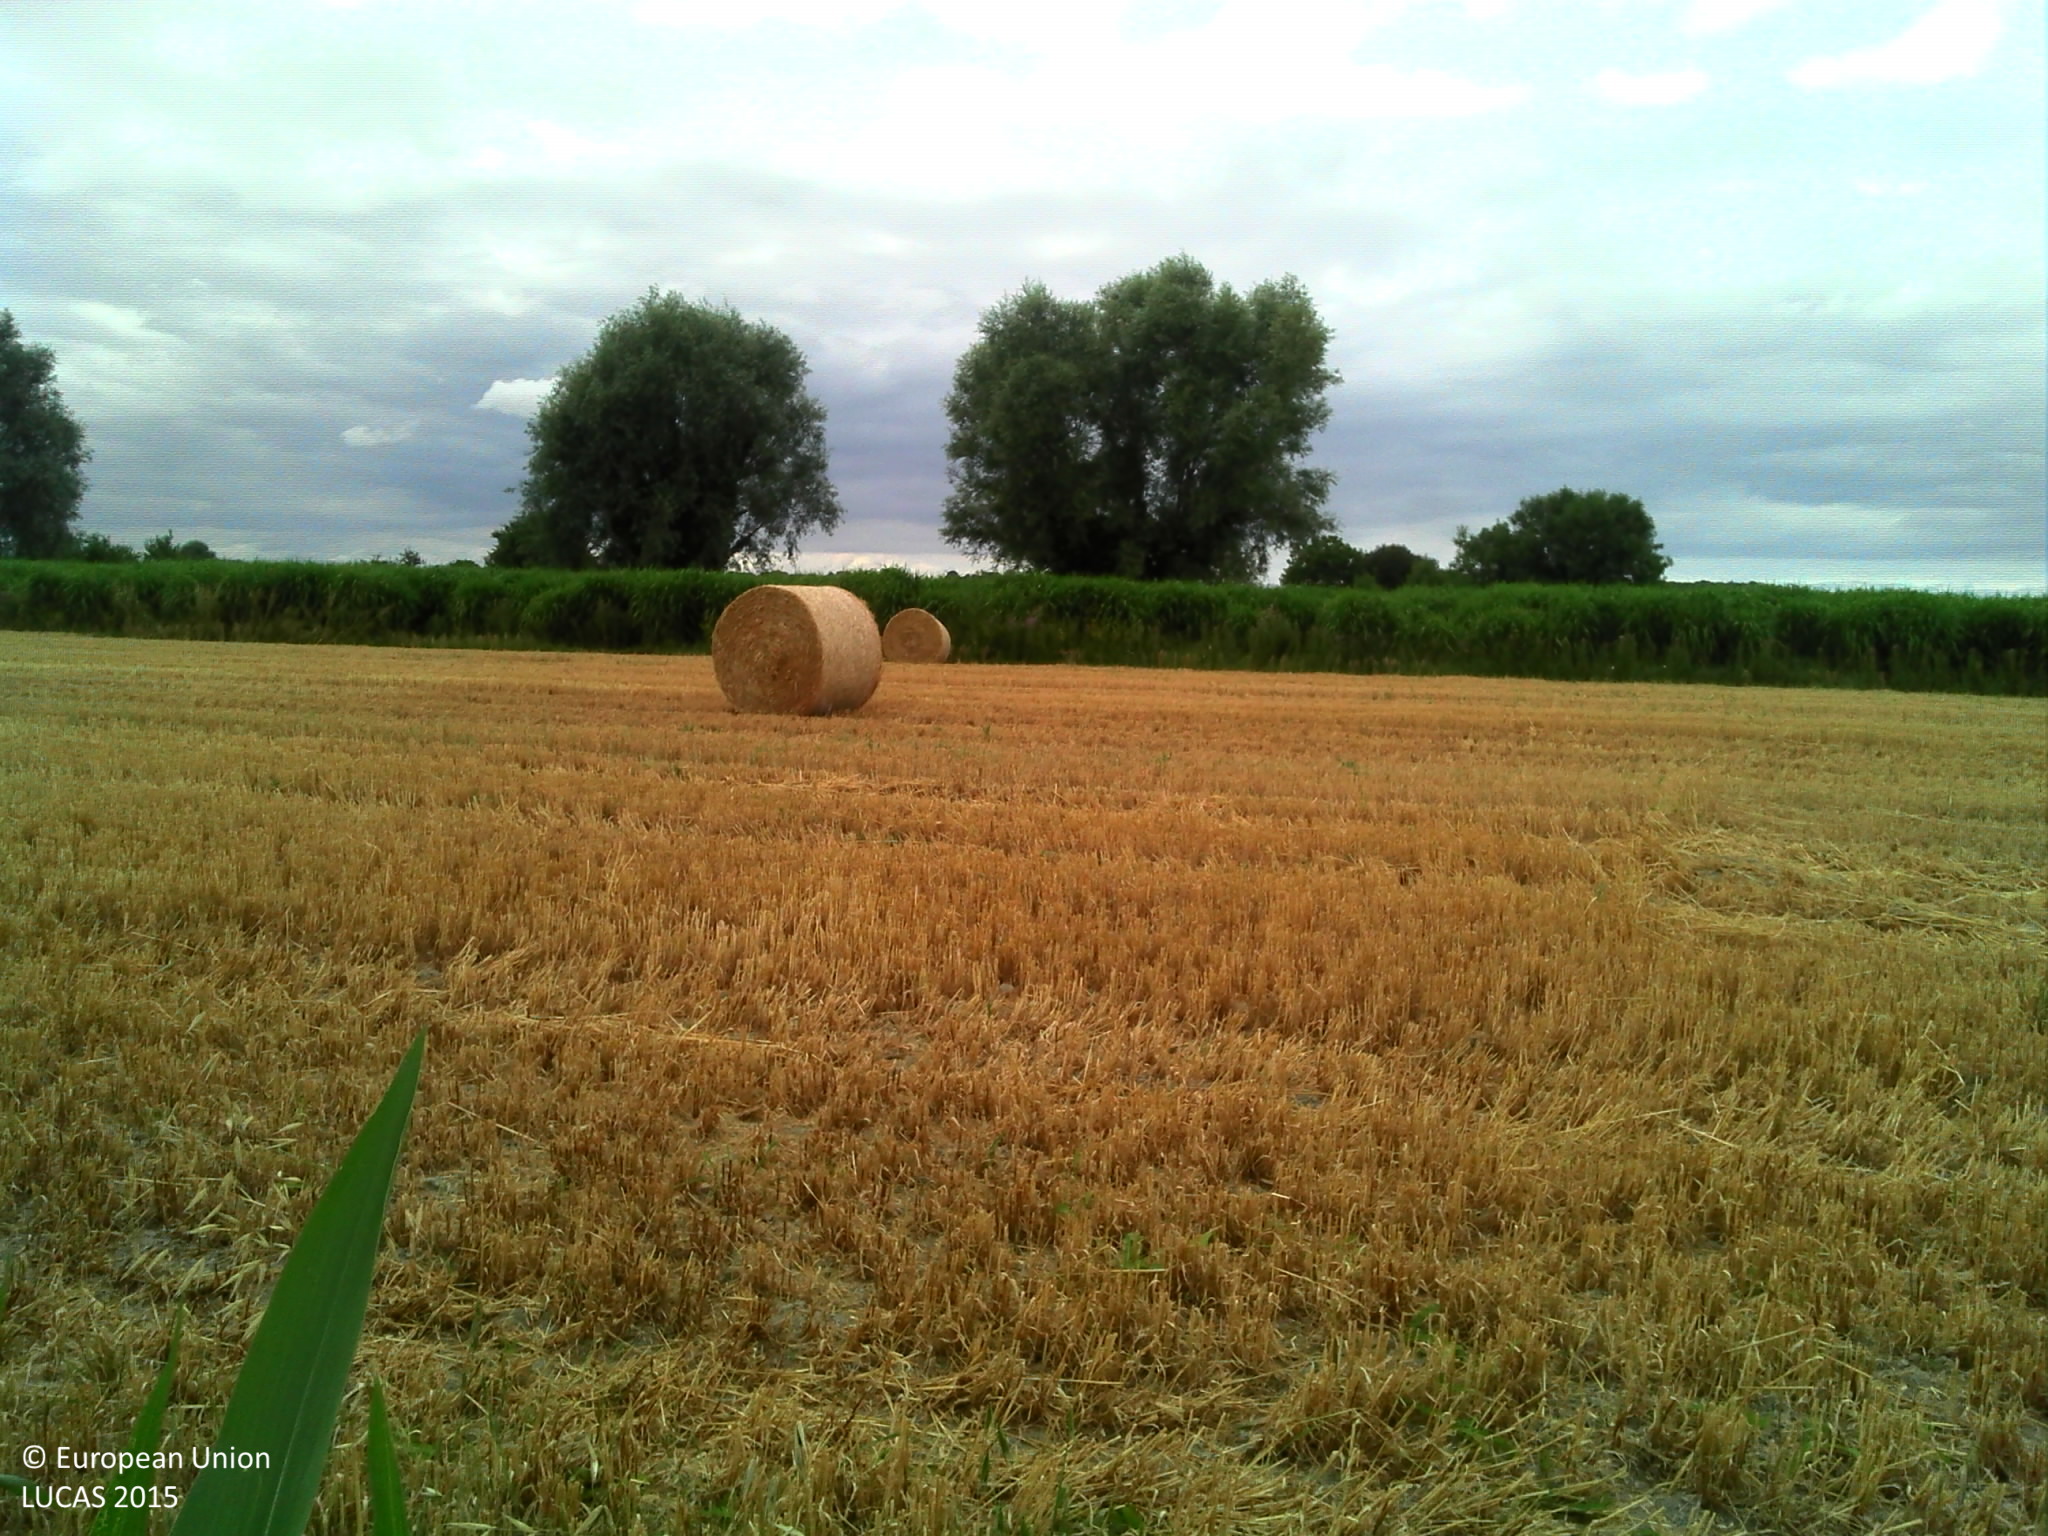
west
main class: Cropland
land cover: Maize
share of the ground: > 75 %
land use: Agriculture (excluding fallow land and kitchen gardens)
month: July
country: FR
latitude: 48.5987
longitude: -1.8632
